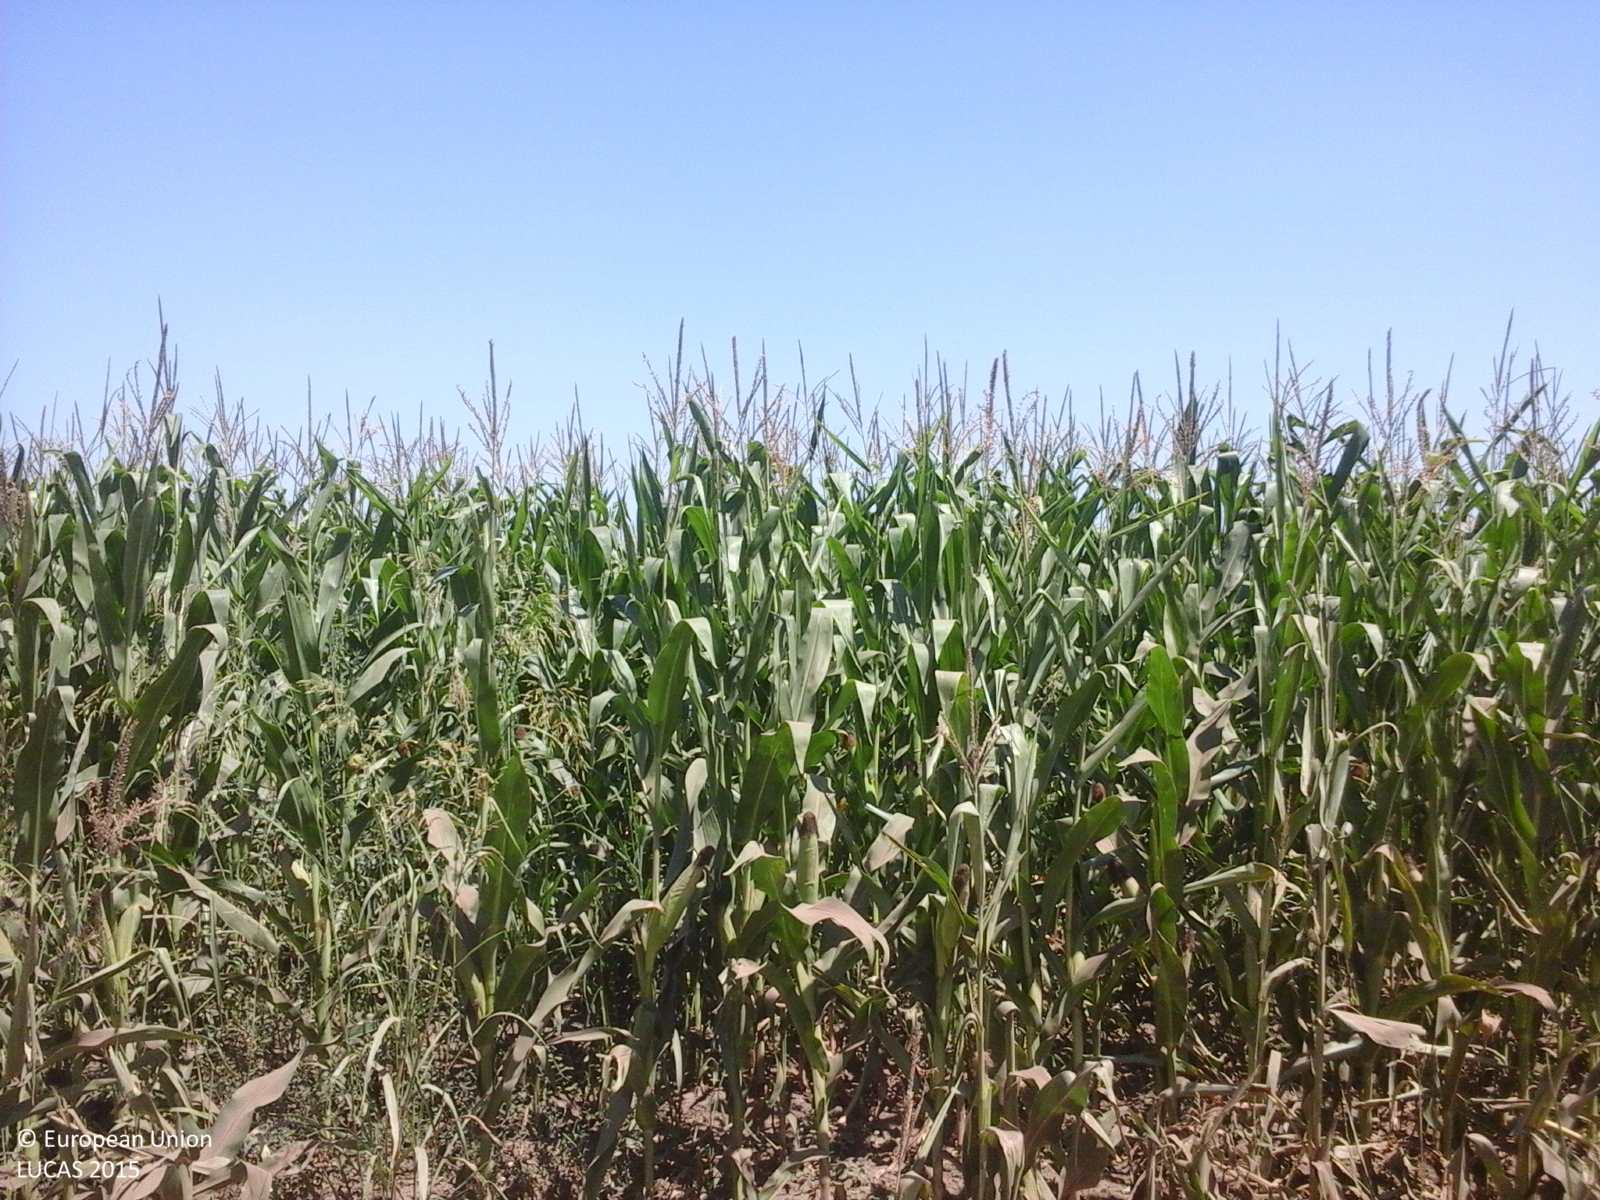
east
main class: Cropland
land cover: Maize
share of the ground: > 75 %
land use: Agriculture (excluding fallow land and kitchen gardens)
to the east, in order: Maize
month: July
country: RO
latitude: 44.1510
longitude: 26.6569
